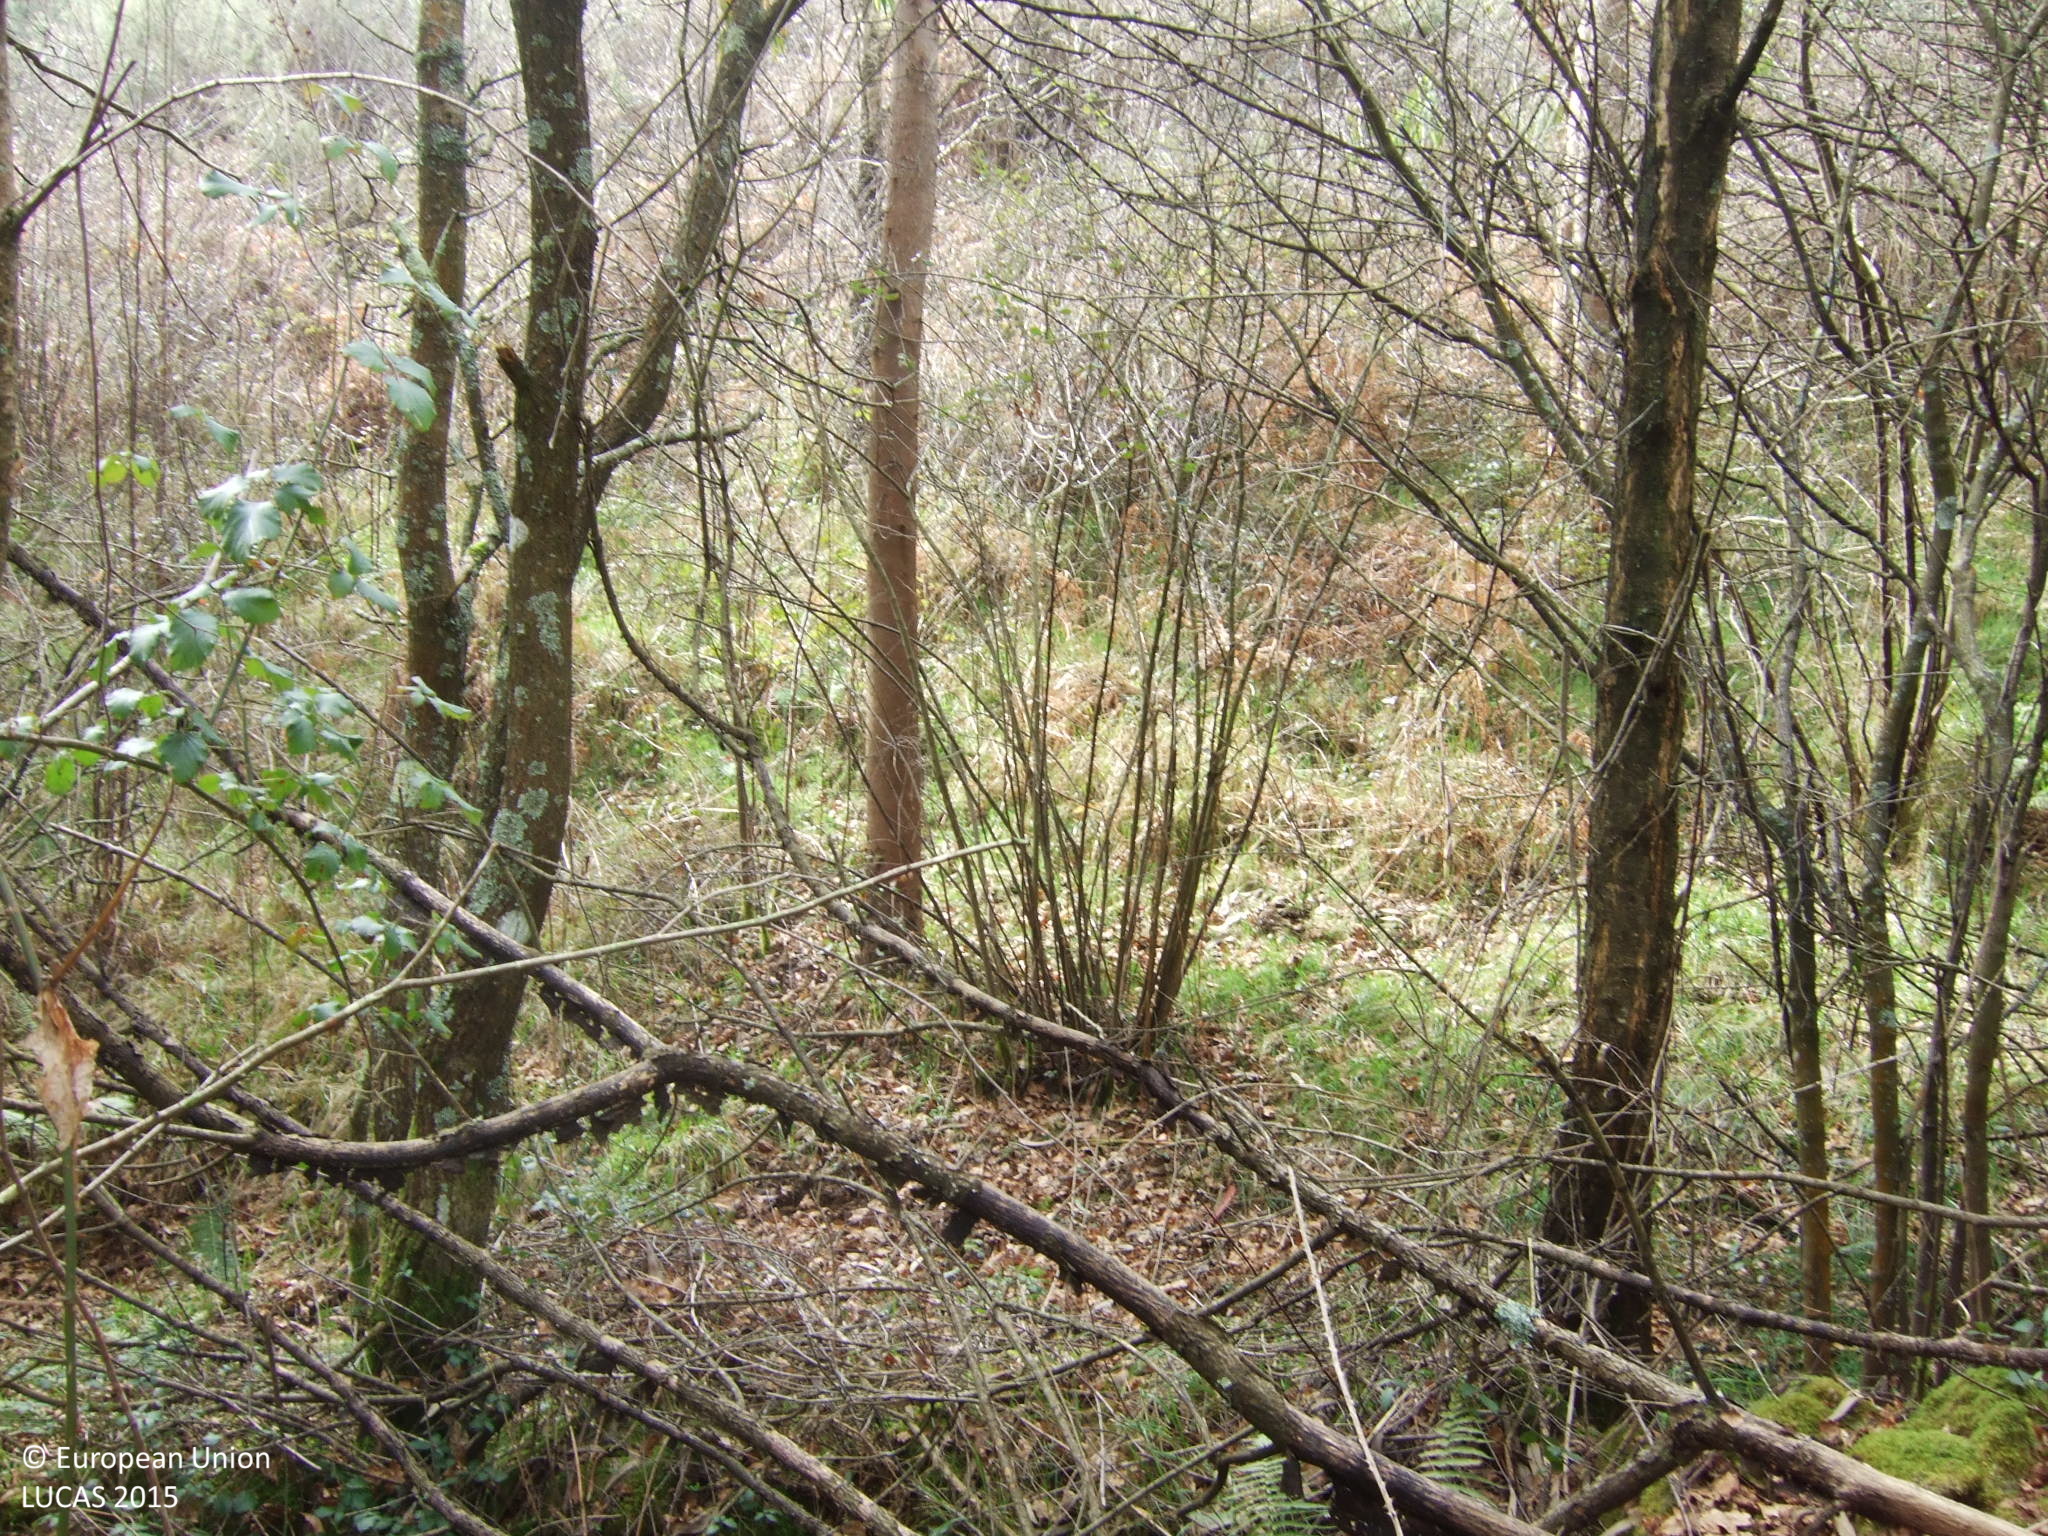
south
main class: Woodland
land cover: Broadleaved woodland
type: exotic forest
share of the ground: > 75 %
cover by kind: broadleaved forest trees 90 %, shrubs 10 %
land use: Forestry
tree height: > 5 m
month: March
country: ES
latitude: 42.9238
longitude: -7.9123
